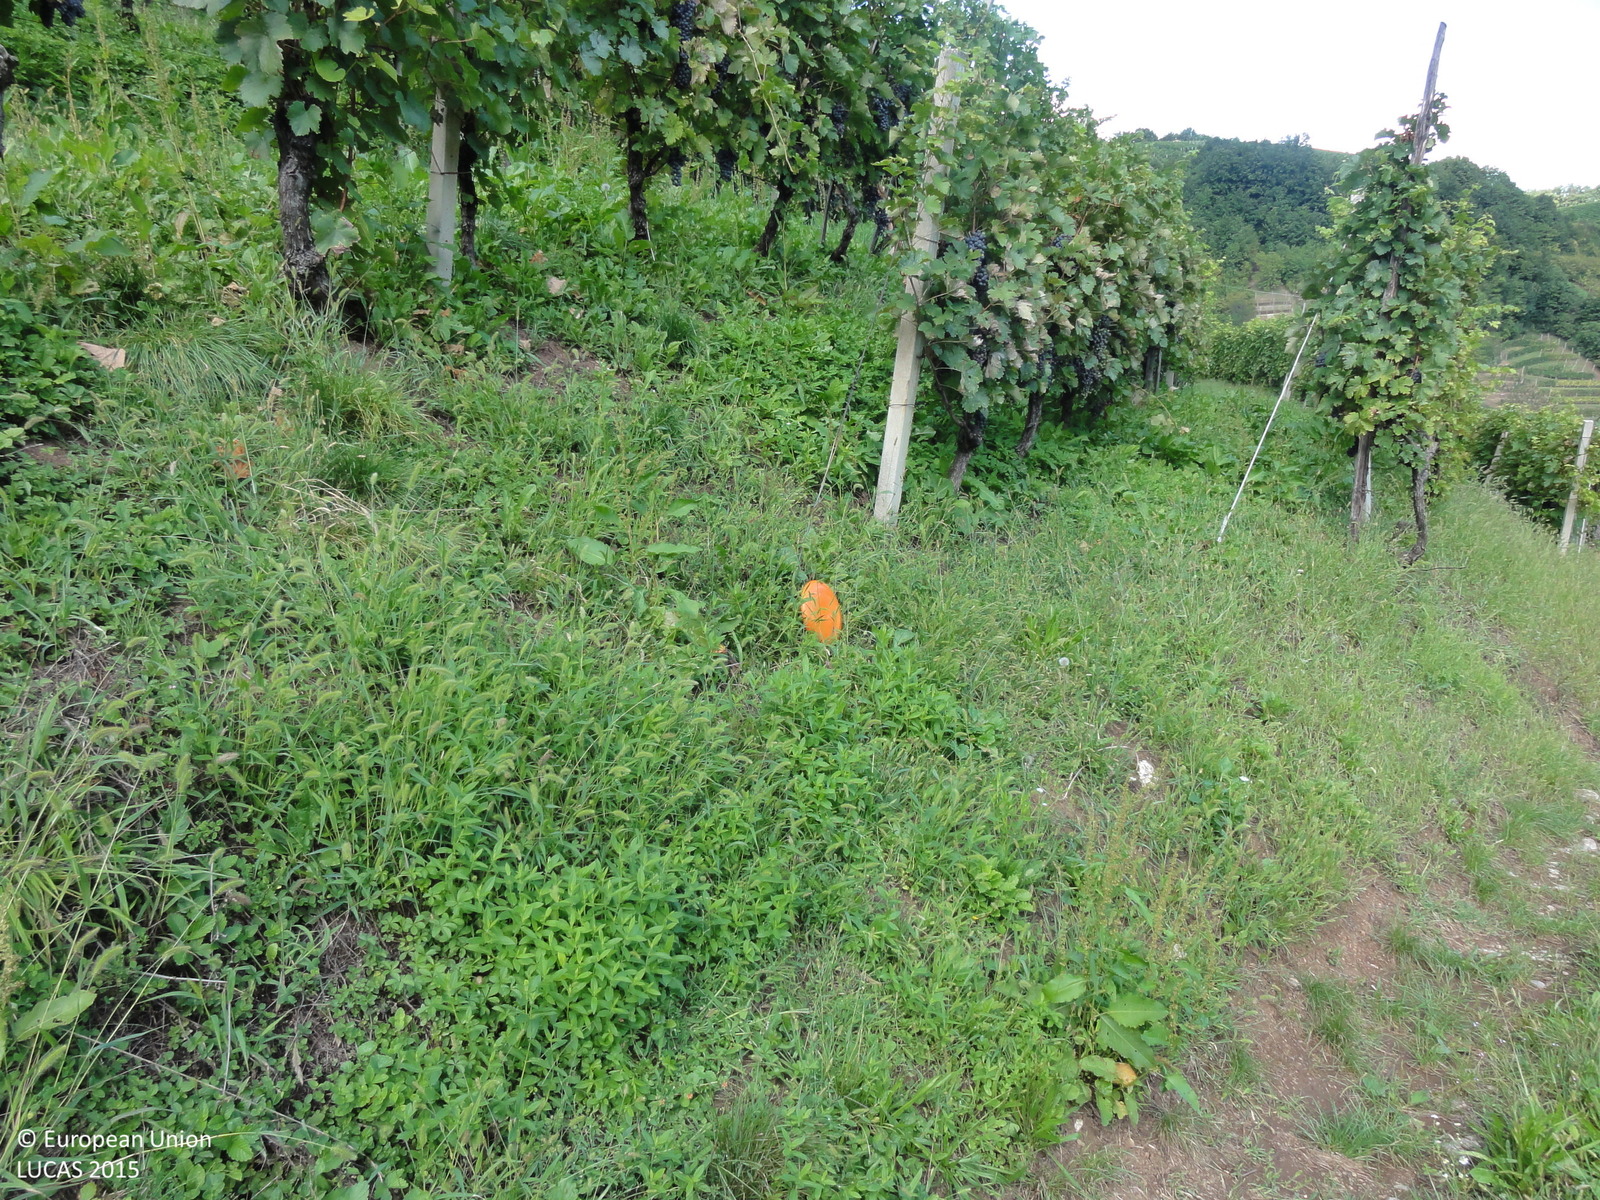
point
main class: Cropland
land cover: Vineyards
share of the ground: 50 - 75 %
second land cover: Grassland without tree/shrub cover
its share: > 75 %
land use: Agriculture (excluding fallow land and kitchen gardens)
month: September
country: SI
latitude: 45.8502
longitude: 15.4701
